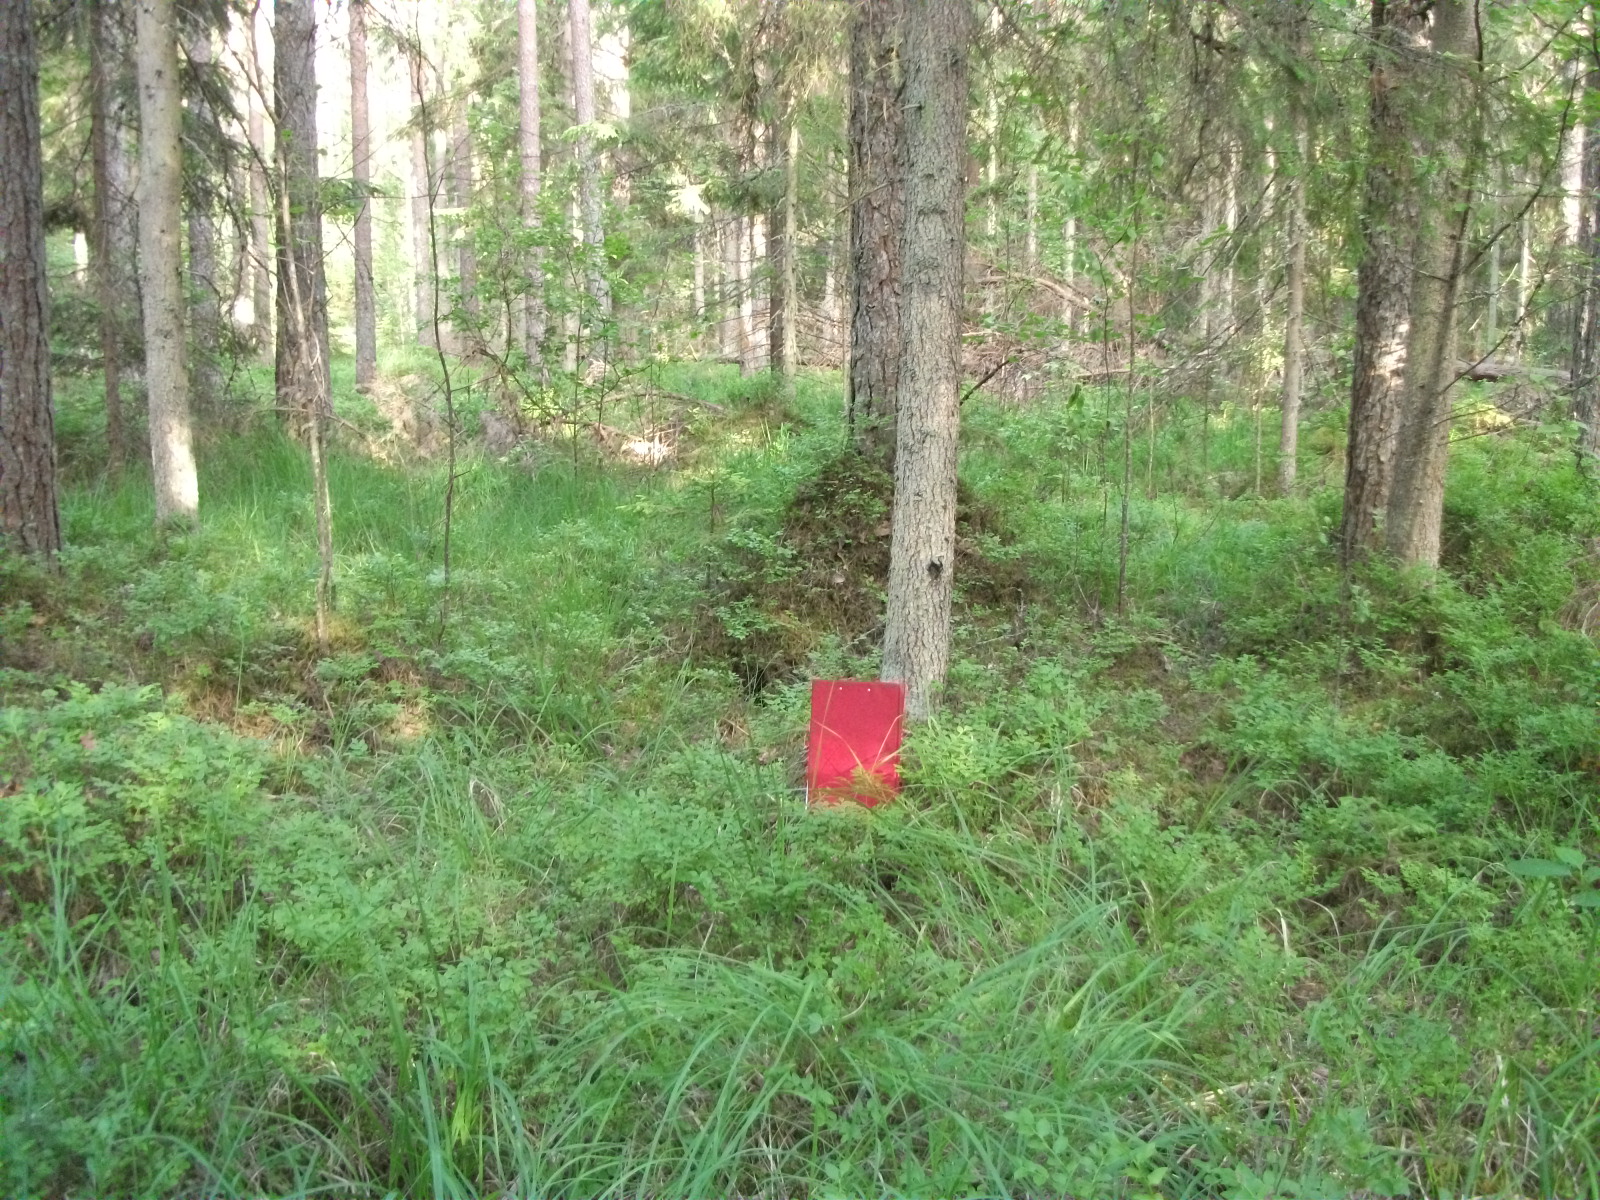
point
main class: Woodland
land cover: Other coniferous woodland
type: hemiboreal forest and nemoral coniferous forest and mixed broadleaved-coniferous forest
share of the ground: > 75 %
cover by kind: coniferous forest trees 80 %, herbaceous plants 10 %, shrubs 5 %, lichens and mosses 5 %
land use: Forestry
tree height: > 5 m
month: June
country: LV
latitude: 56.9578
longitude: 26.5754
